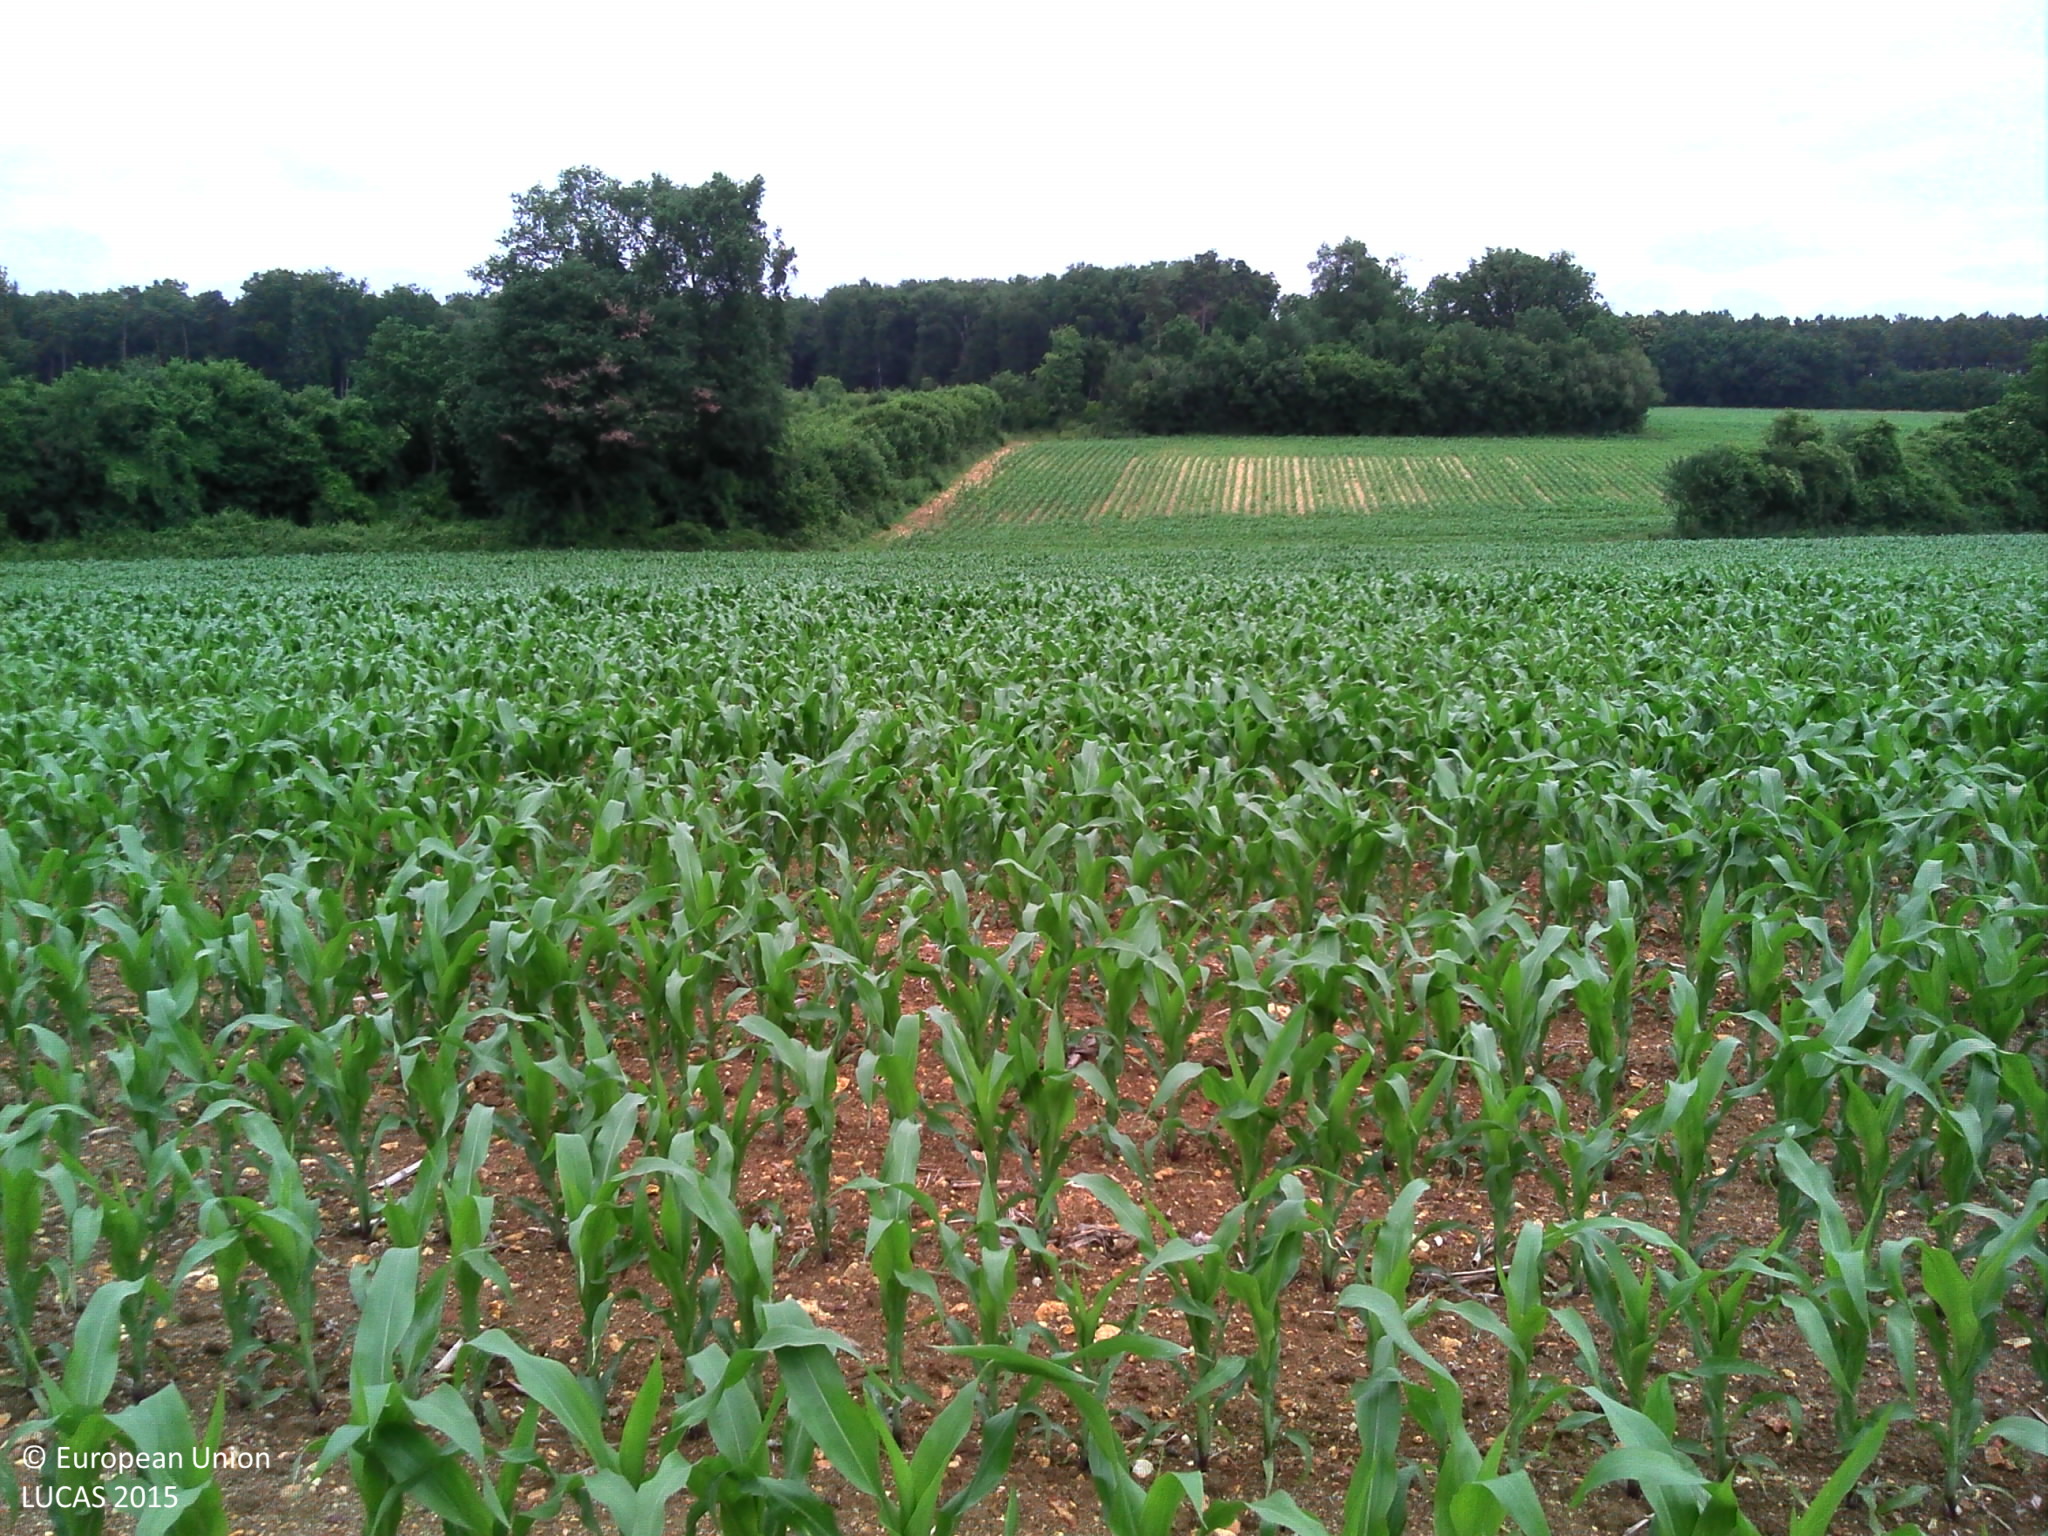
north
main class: Cropland
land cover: Maize
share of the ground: 50 - 75 %
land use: Agriculture (excluding fallow land and kitchen gardens)
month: June
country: FR
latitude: 46.4928
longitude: 0.5372
